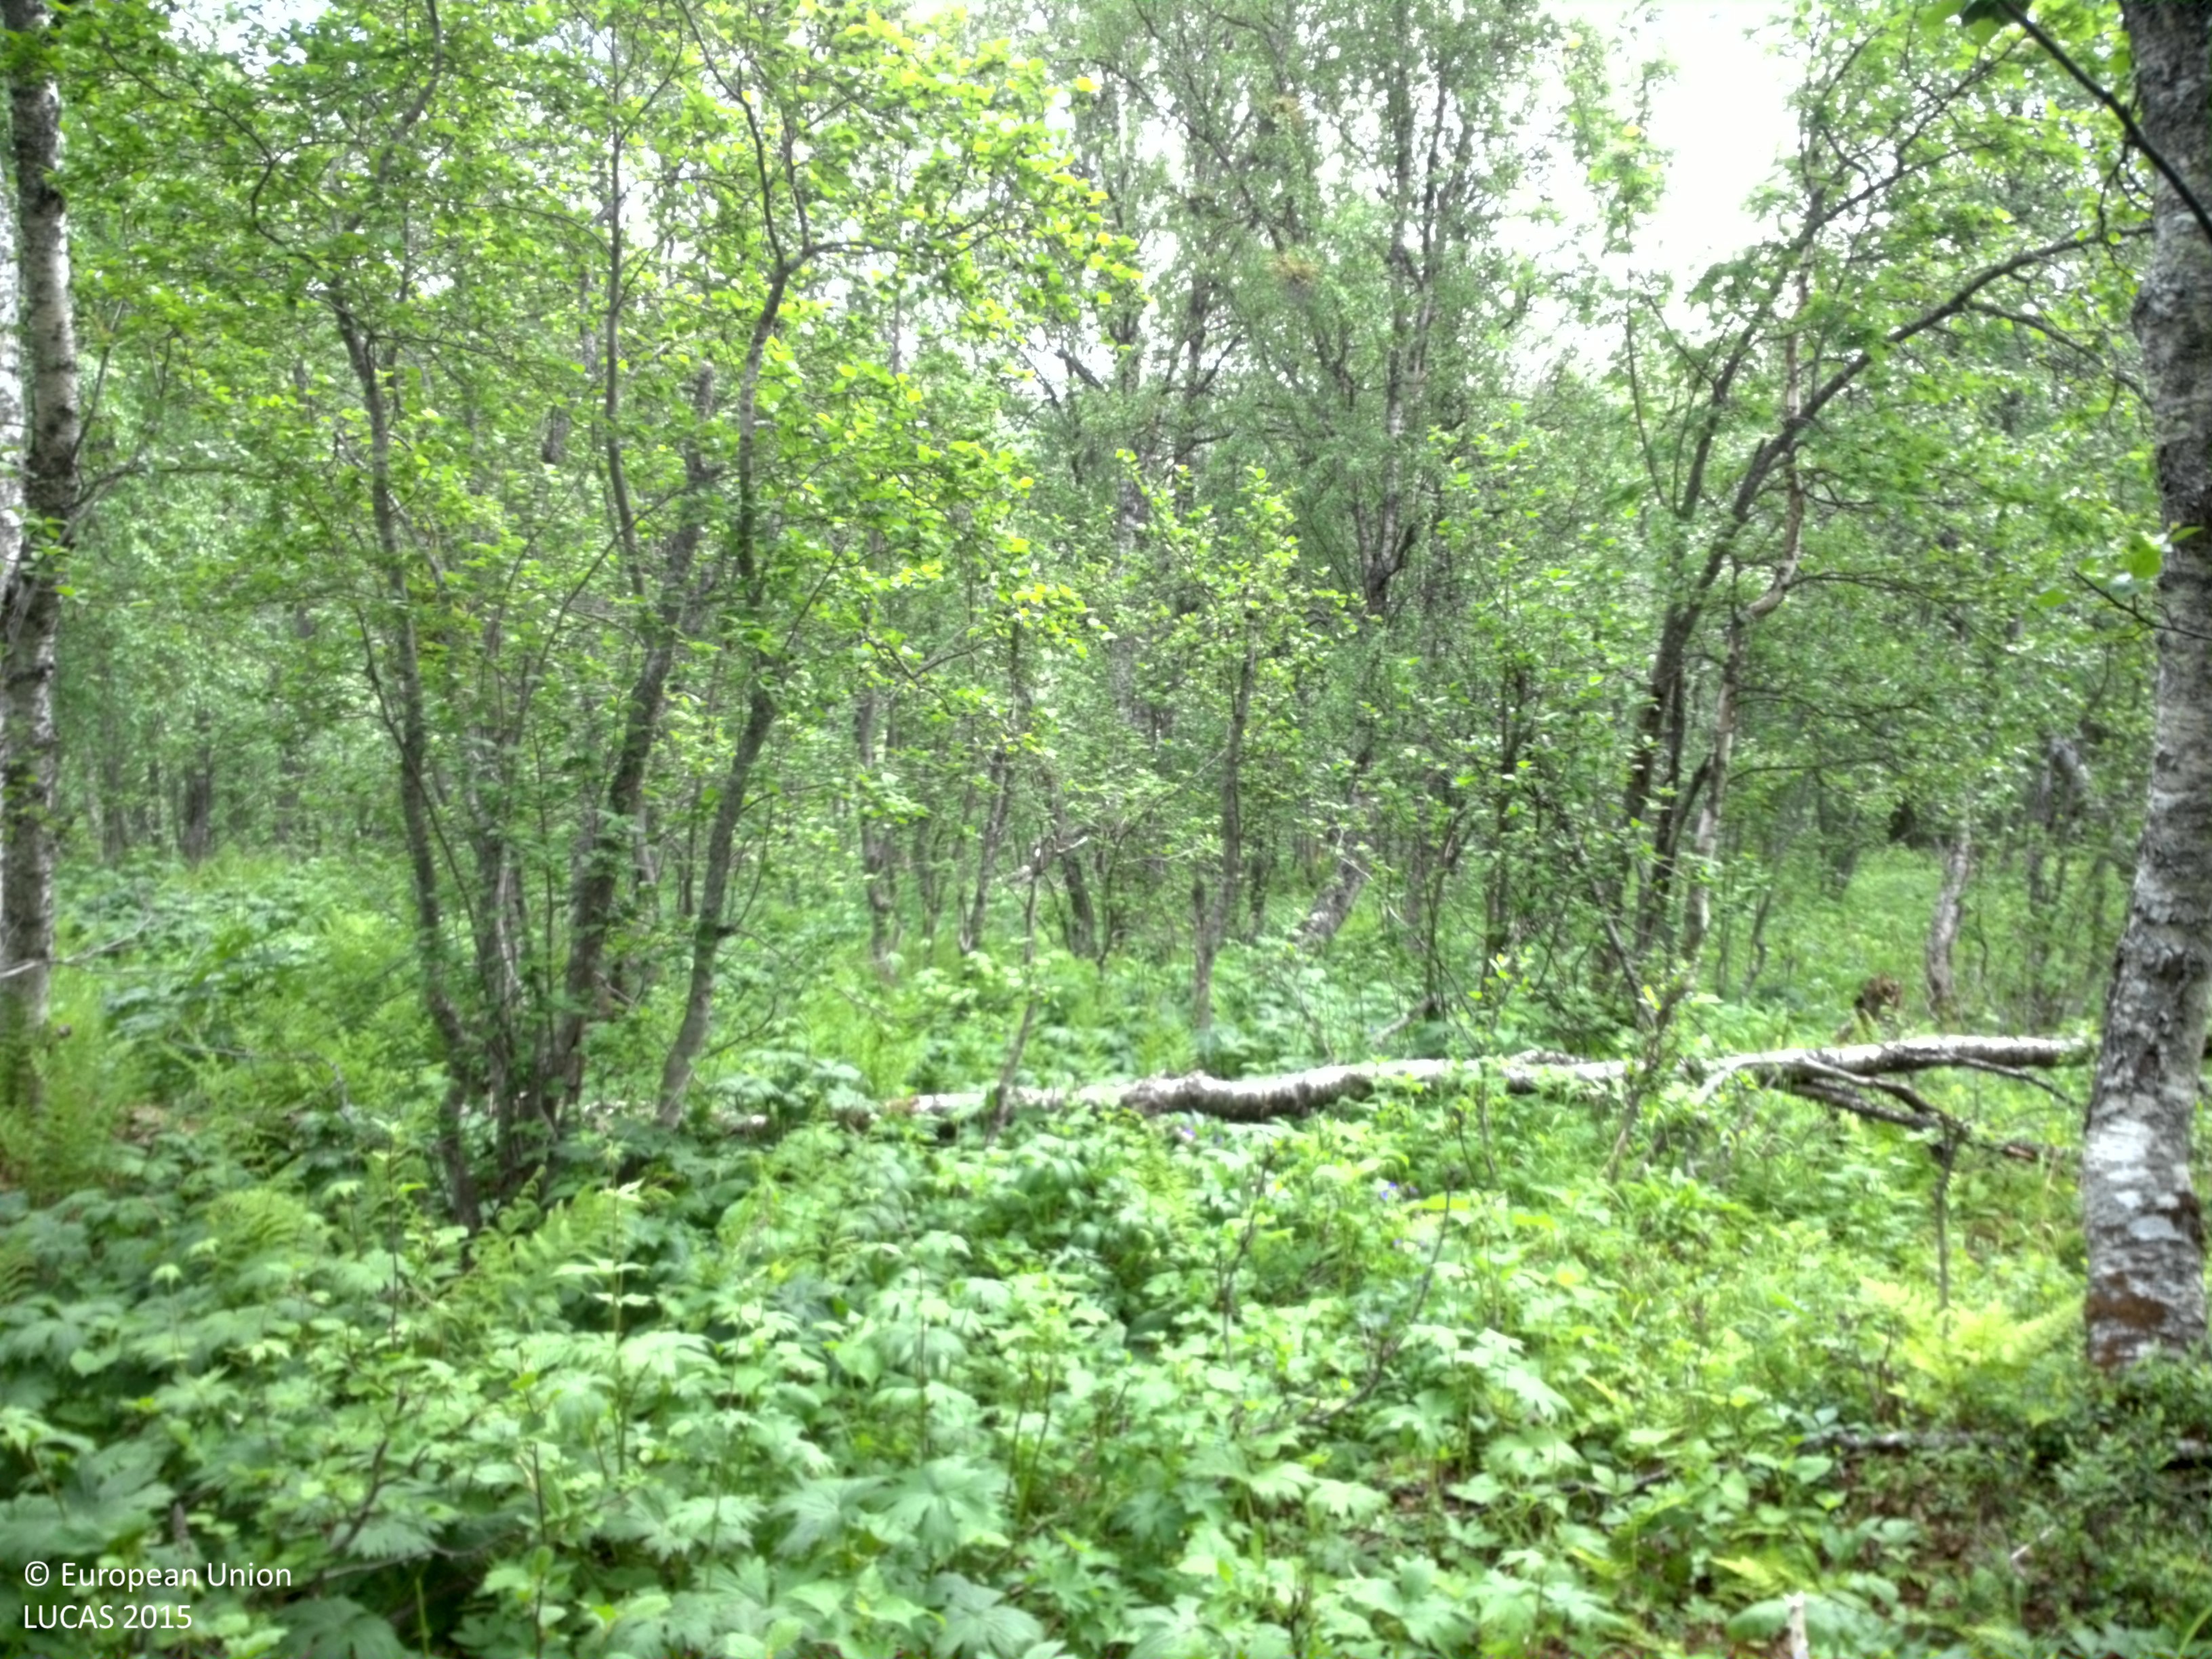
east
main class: Woodland
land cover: Broadleaved woodland
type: non-riverine alder, birch or aspen forest
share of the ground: 25 - 50 %
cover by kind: herbaceous plants 55 %, broadleaved forest trees 40 %, shrubs 5 %
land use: Semi-natural and natural areas not in use
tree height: > 5 m
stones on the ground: < 10 %
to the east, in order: Broadleaved woodland
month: July
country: SE
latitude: 65.6735
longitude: 15.1214
